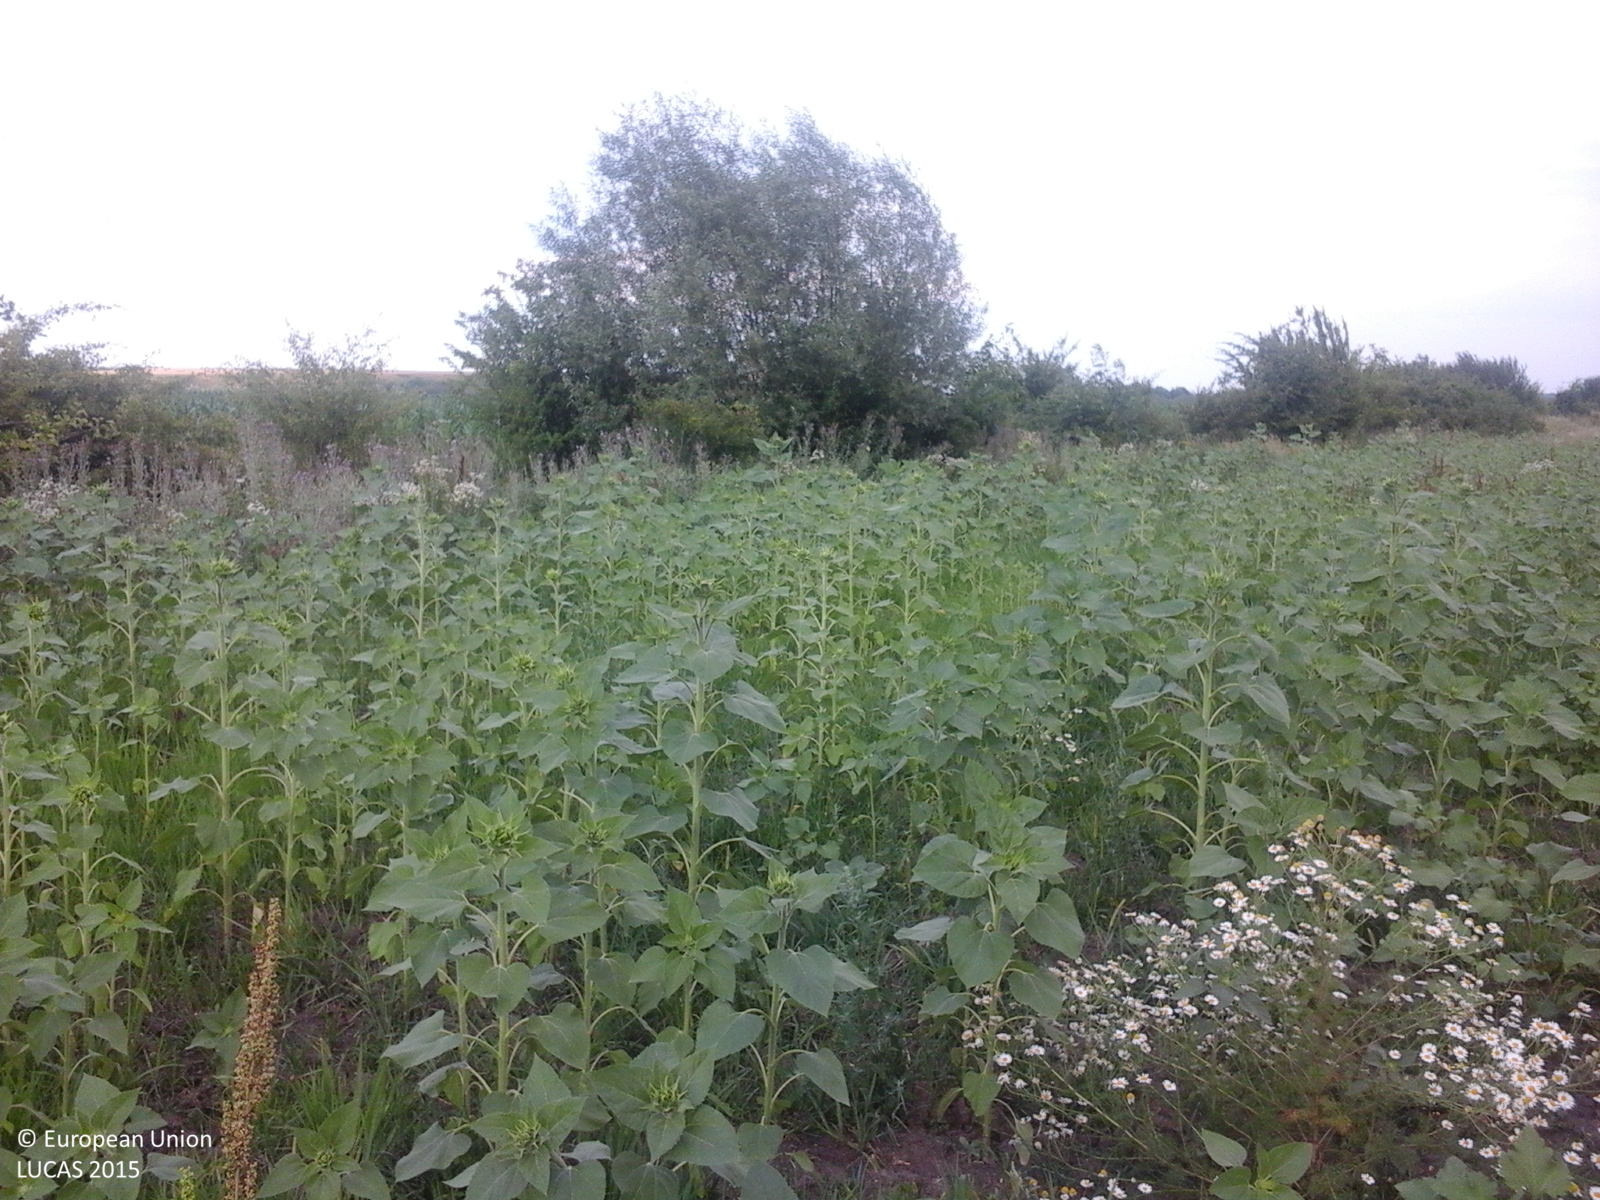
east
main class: Cropland
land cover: Sunflower
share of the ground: 50 - 75 %
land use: Agriculture (excluding fallow land and kitchen gardens)
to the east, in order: Sunflower; Grass margins; Abandoned hedges; Ditches and canals; Grass margins; Tracks; Grass margins; Maize
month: June
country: RO
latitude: 44.2834
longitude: 25.8230
